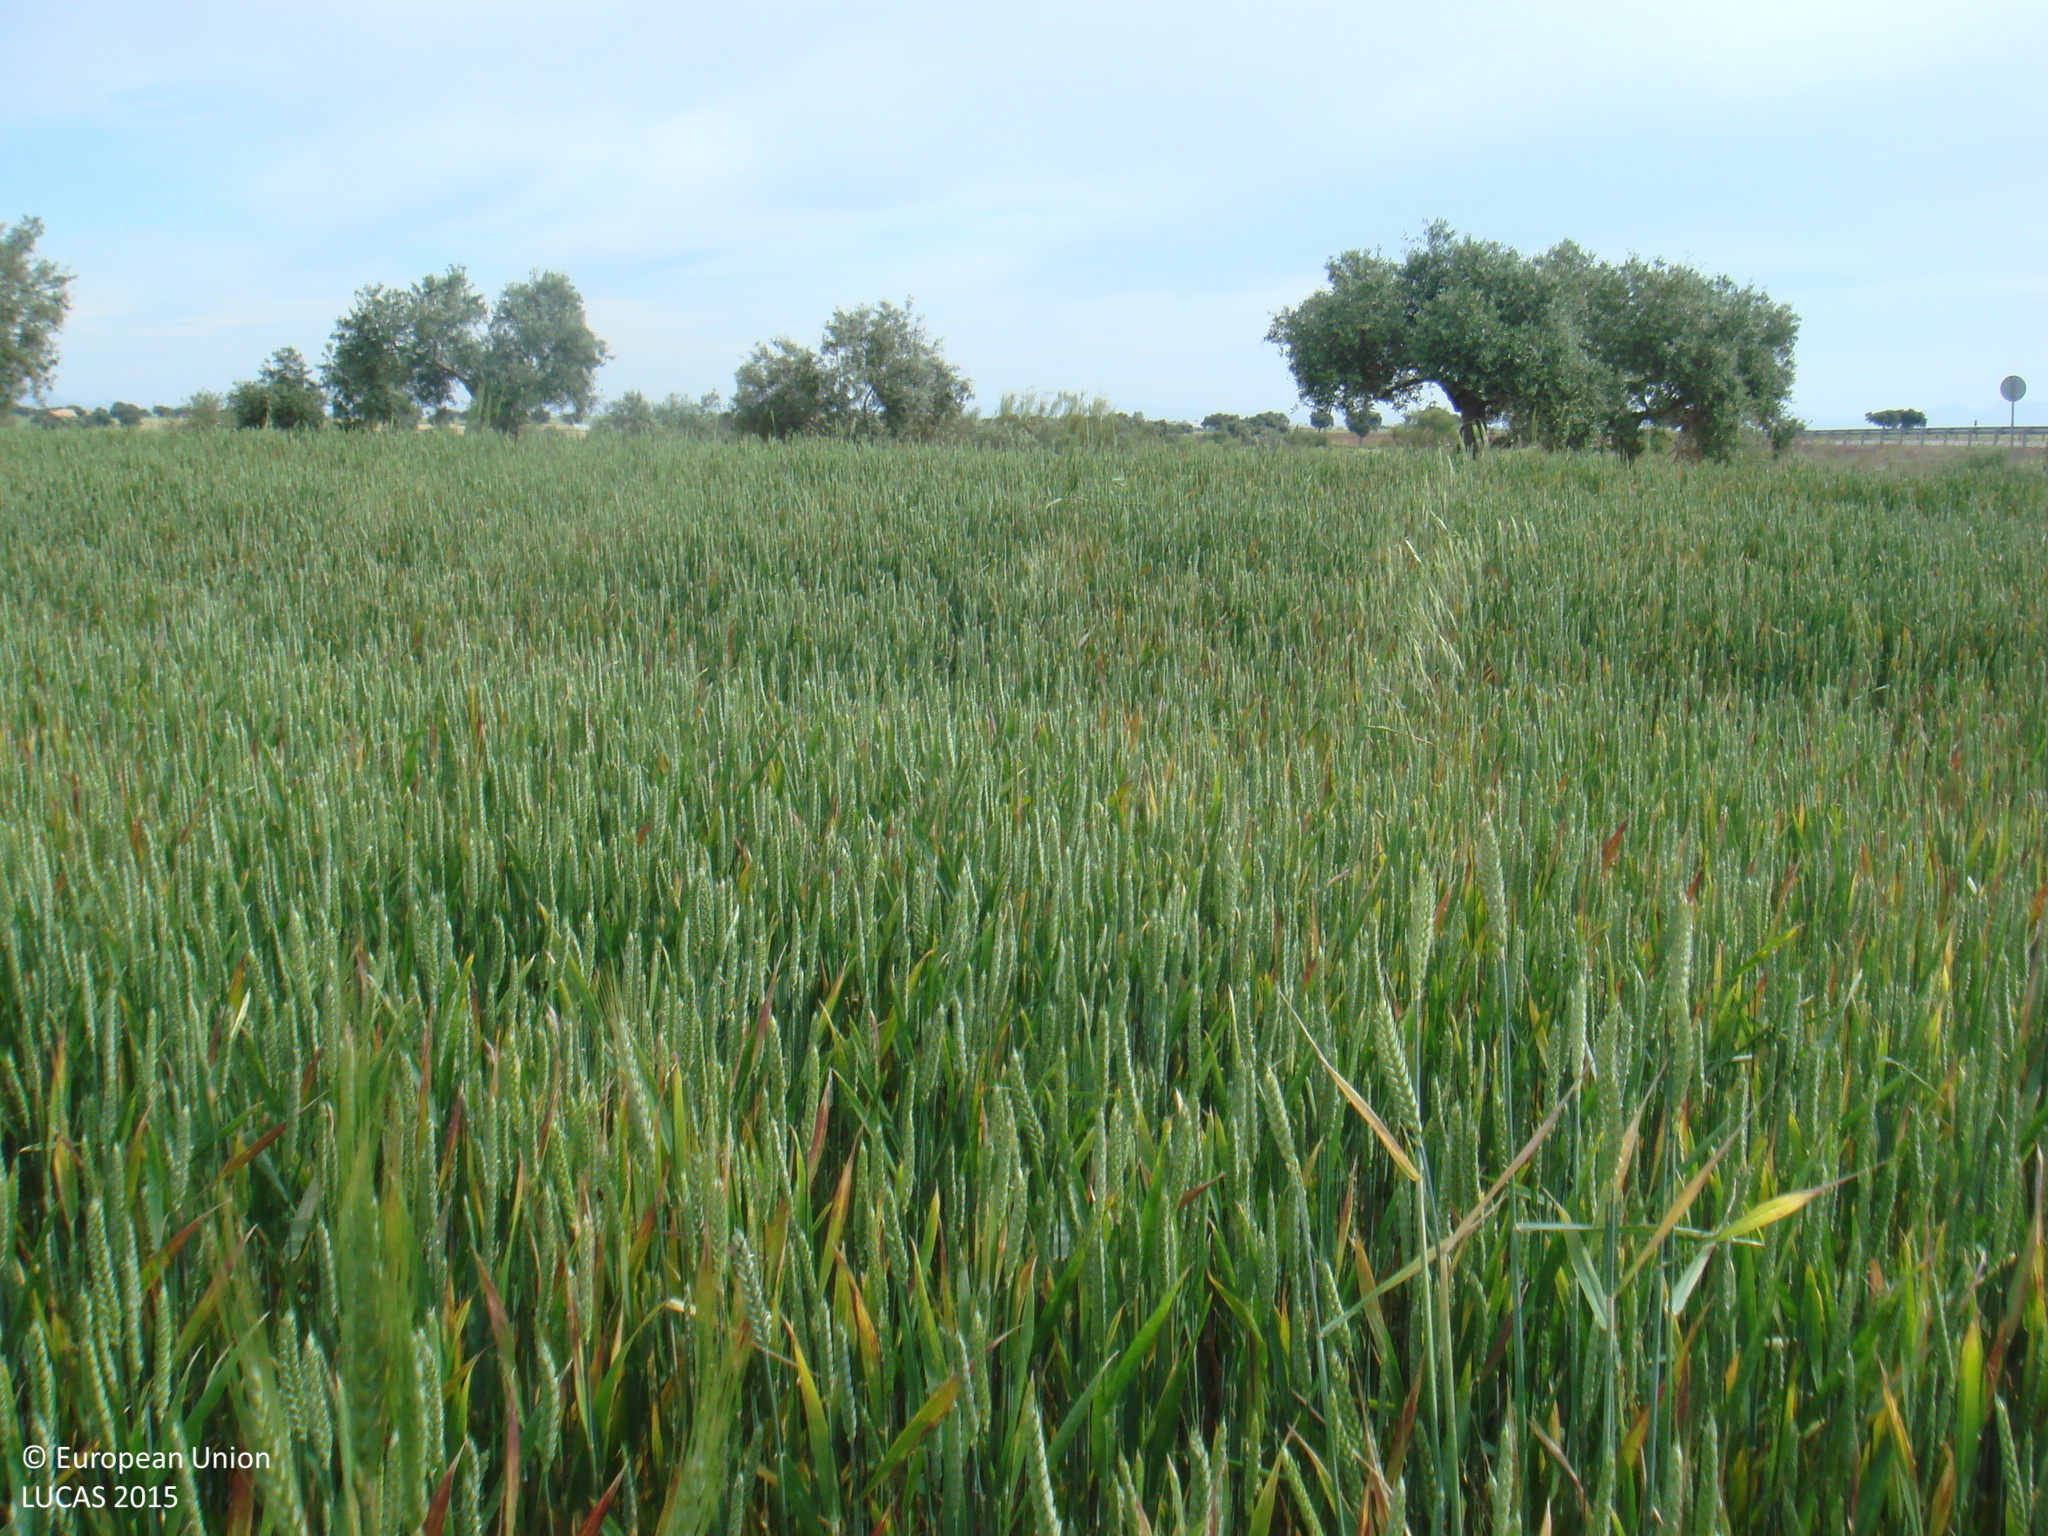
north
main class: Cropland
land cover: Common wheat
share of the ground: > 75 %
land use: Agriculture (excluding fallow land and kitchen gardens)
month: May
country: ES
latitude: 38.4591
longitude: -5.1447
